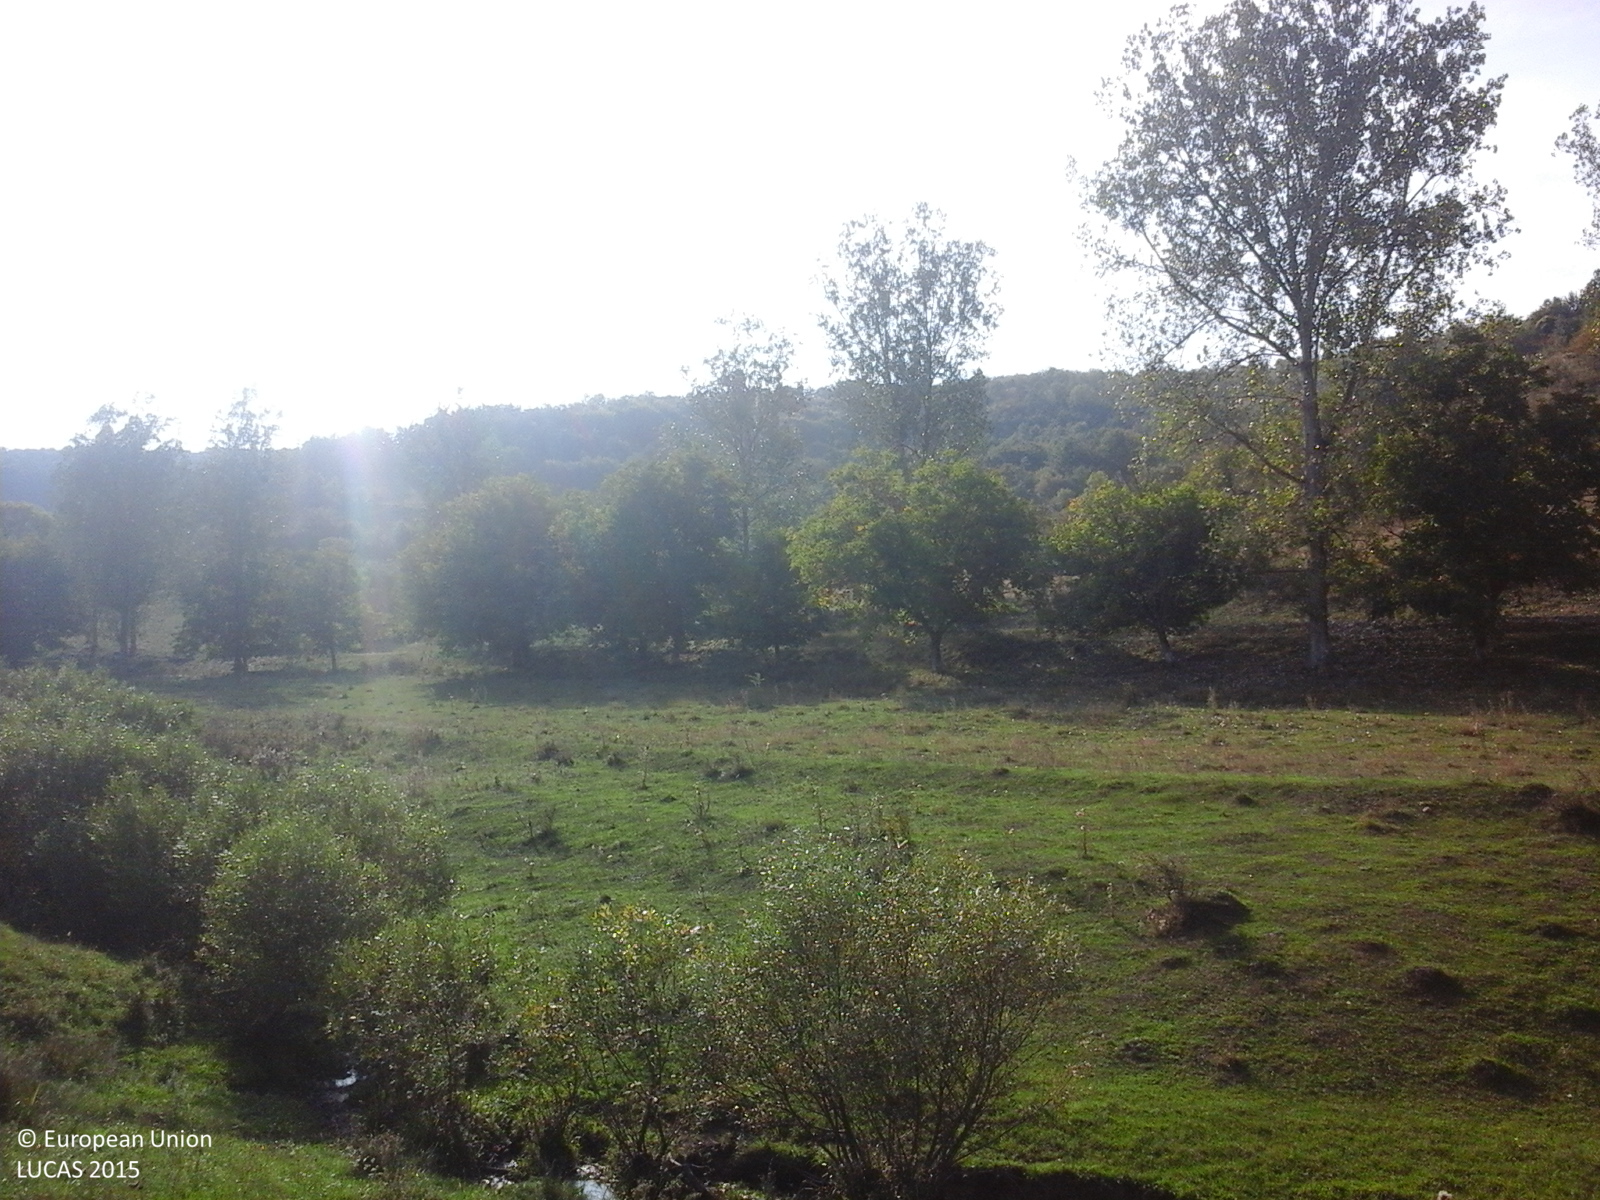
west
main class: Grassland
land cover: Grassland without tree/shrub cover
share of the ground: > 75 %
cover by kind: herbaceous plants 100 %
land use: Agriculture (excluding fallow land and kitchen gardens)
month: September
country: RO
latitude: 47.0184
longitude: 23.3957
